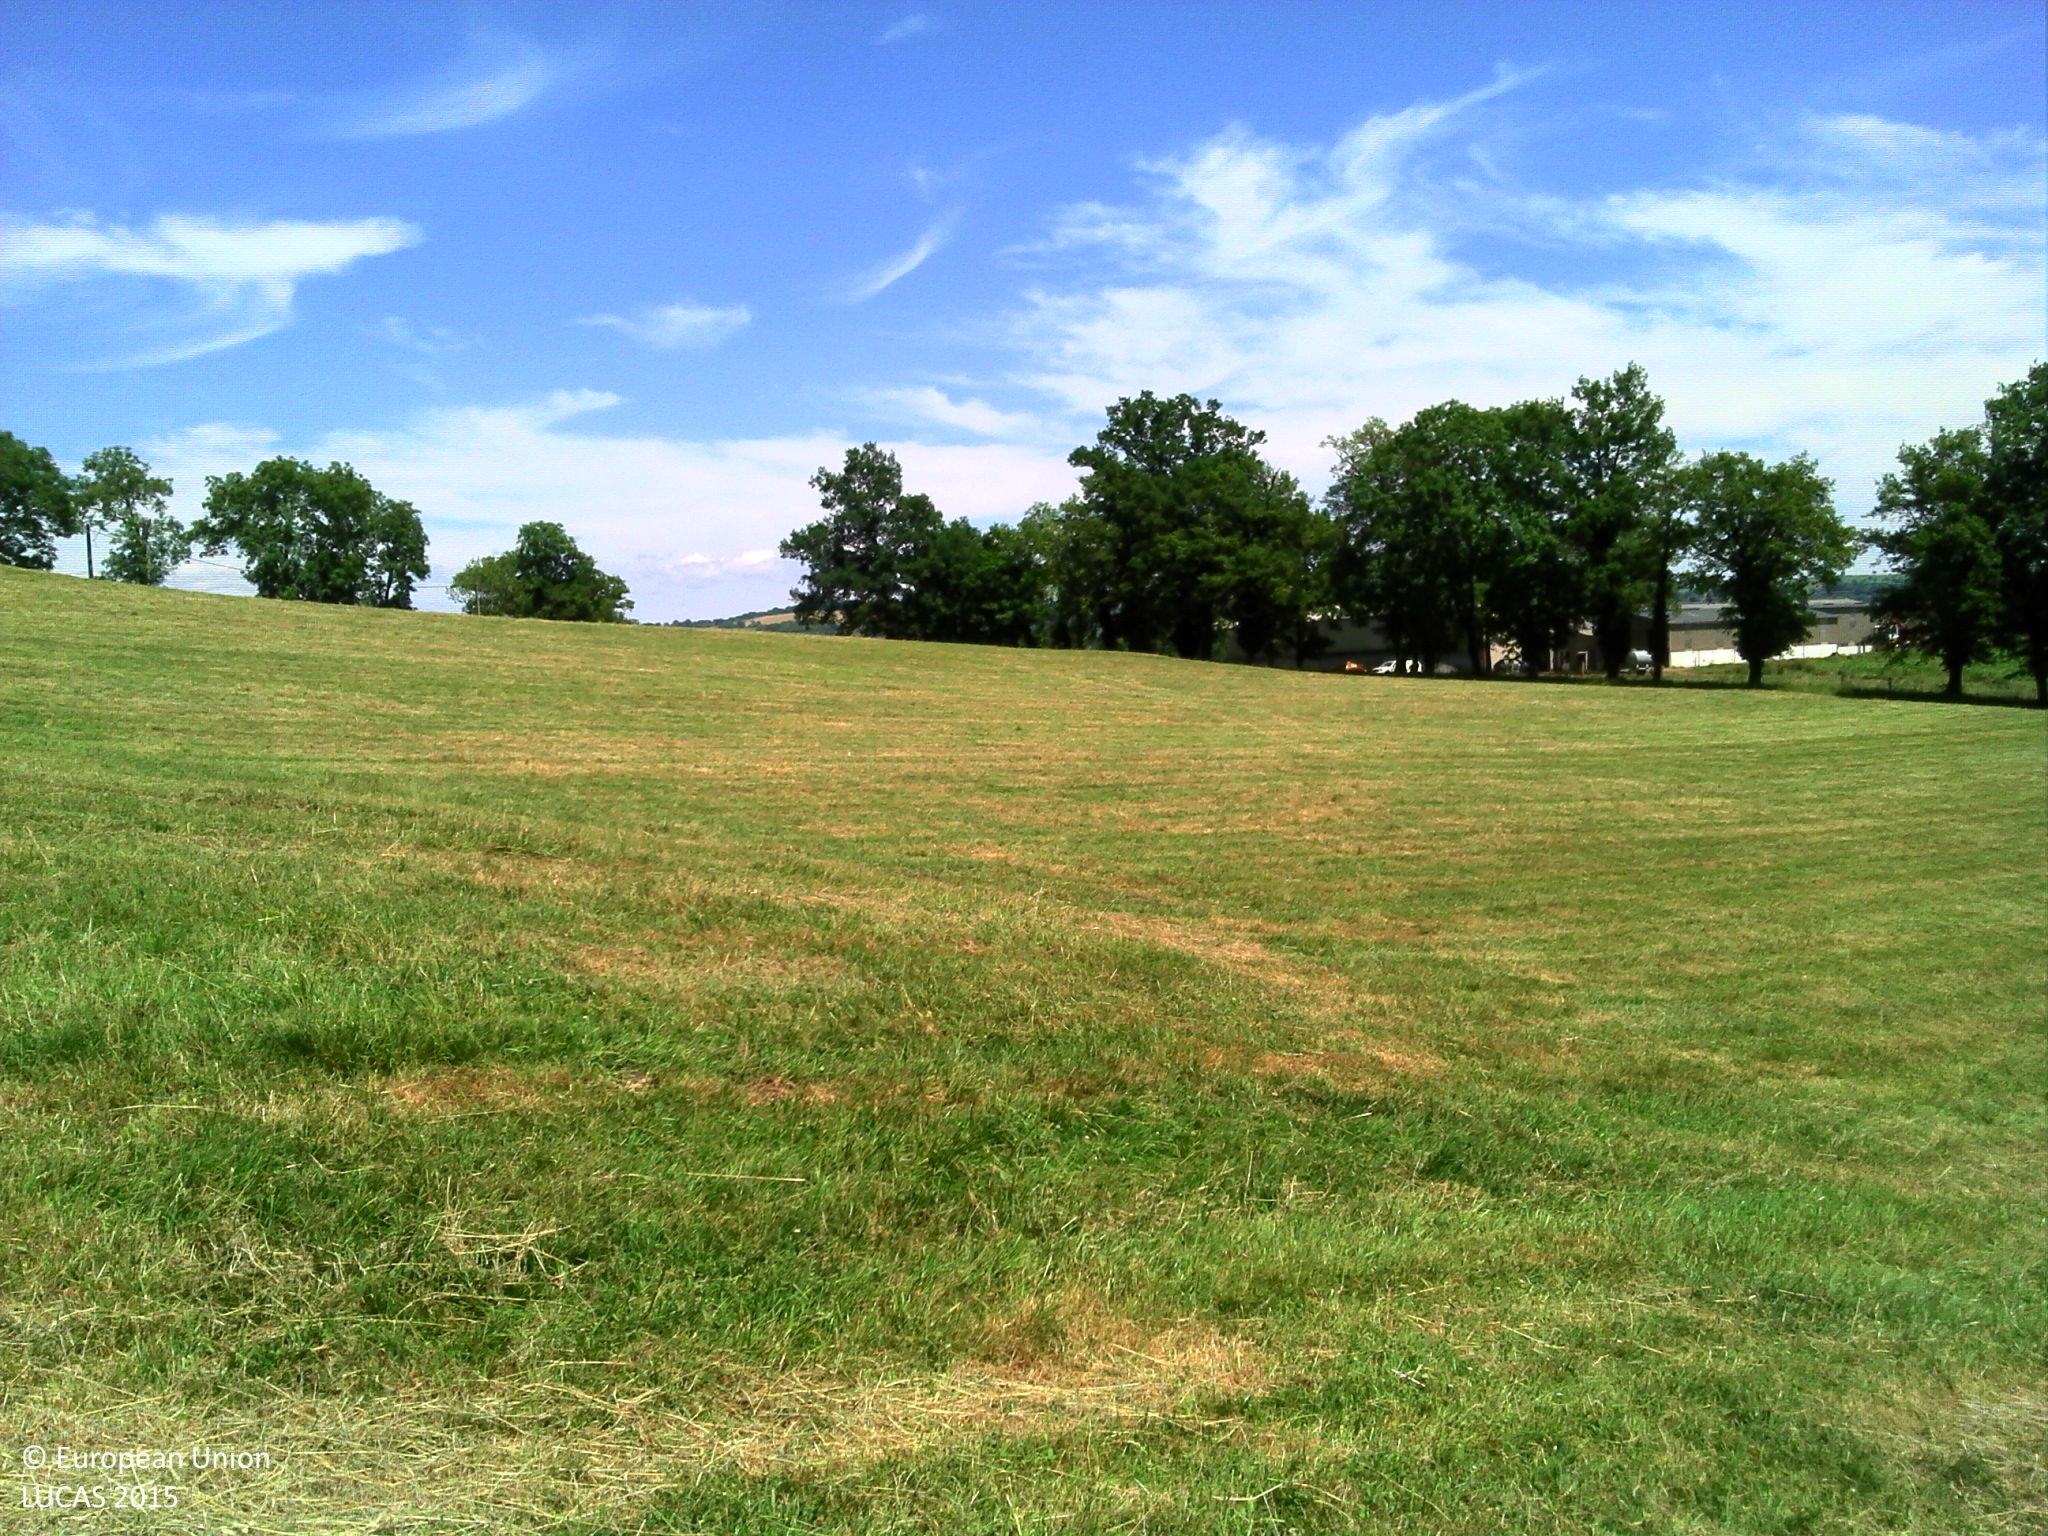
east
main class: Grassland
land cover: Grassland without tree/shrub cover
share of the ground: > 75 %
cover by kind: herbaceous plants 100 %
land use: Agriculture (excluding fallow land and kitchen gardens)
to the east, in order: Grassland without tree/shrub cover; Fences; Lines of trees; Ditches and canals; Grass margins; Paved roads, cycling and walking lanes; Grass margins; Fences; Grassland without tree/shrub cover; Fences; Grass margins; Paved roads, cycling and walking lanes; Grass margins; Fences; Lines of trees; Grassland without tree/shrub cover; Grassland with sparse tree/shrub cover; Fences; Other bare soil; Spontaneously vegetated surfaces
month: June
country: FR
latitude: 44.9574
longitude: 2.3816
